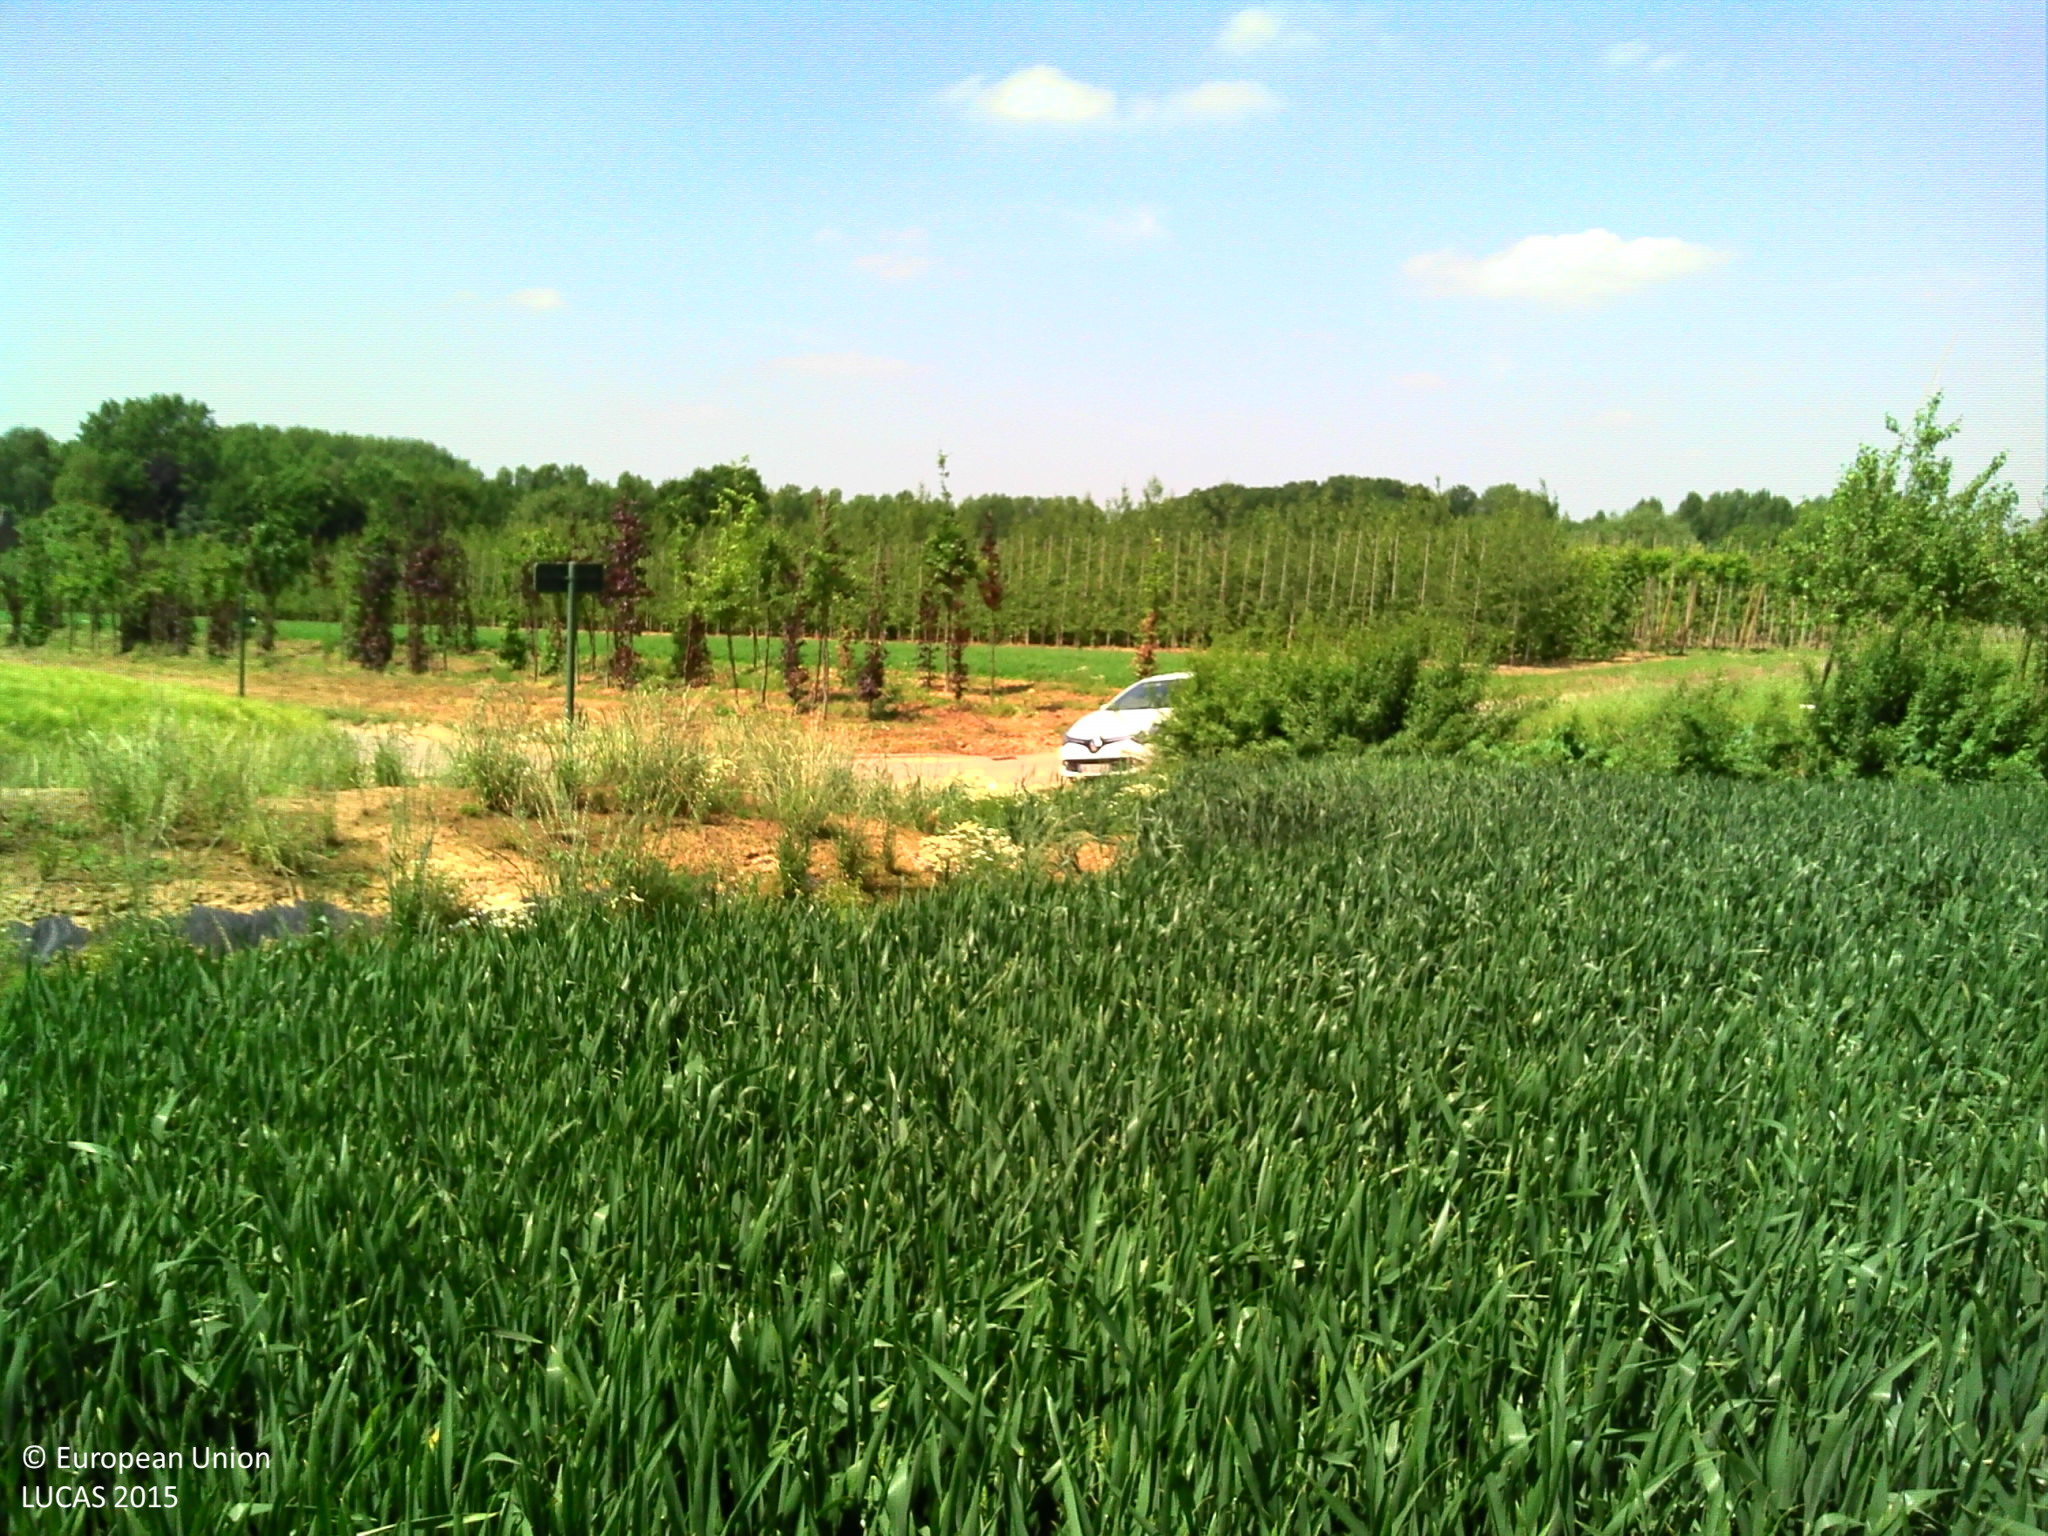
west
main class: Cropland
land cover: Common wheat
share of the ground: > 75 %
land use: Agriculture (excluding fallow land and kitchen gardens)
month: June
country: BE
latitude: 50.9175
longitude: 3.8058
